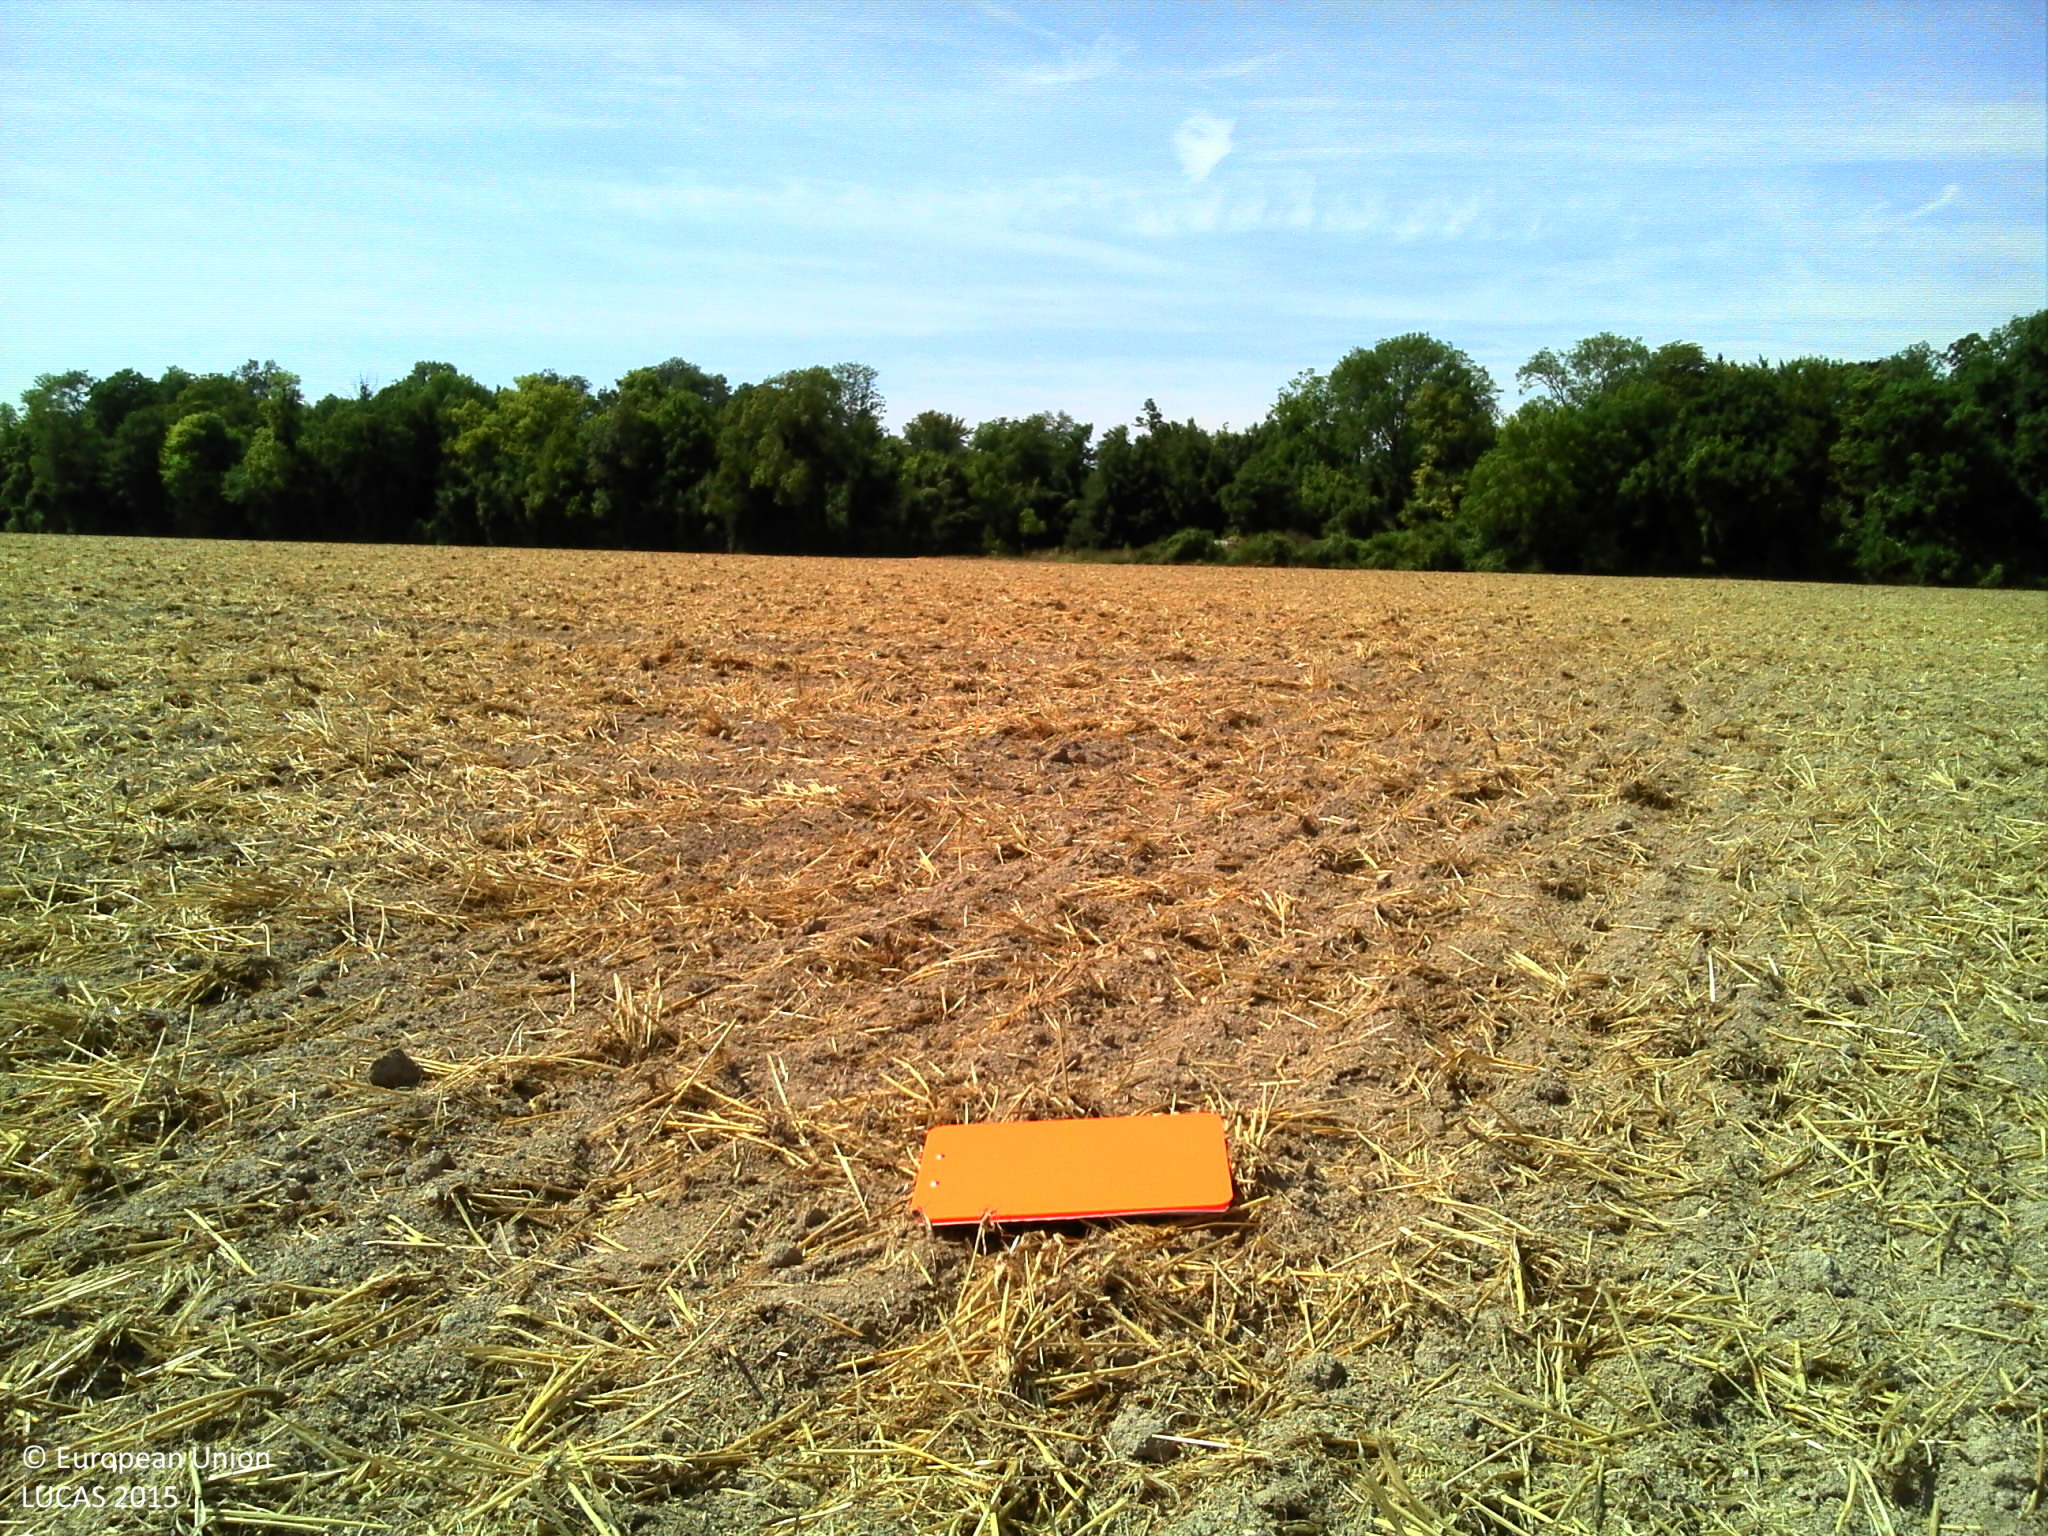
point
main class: Cropland
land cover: Common wheat
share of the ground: > 75 %
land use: Agriculture (excluding fallow land and kitchen gardens)
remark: Harvested field
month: August
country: FR
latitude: 48.9722
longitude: 4.1898
